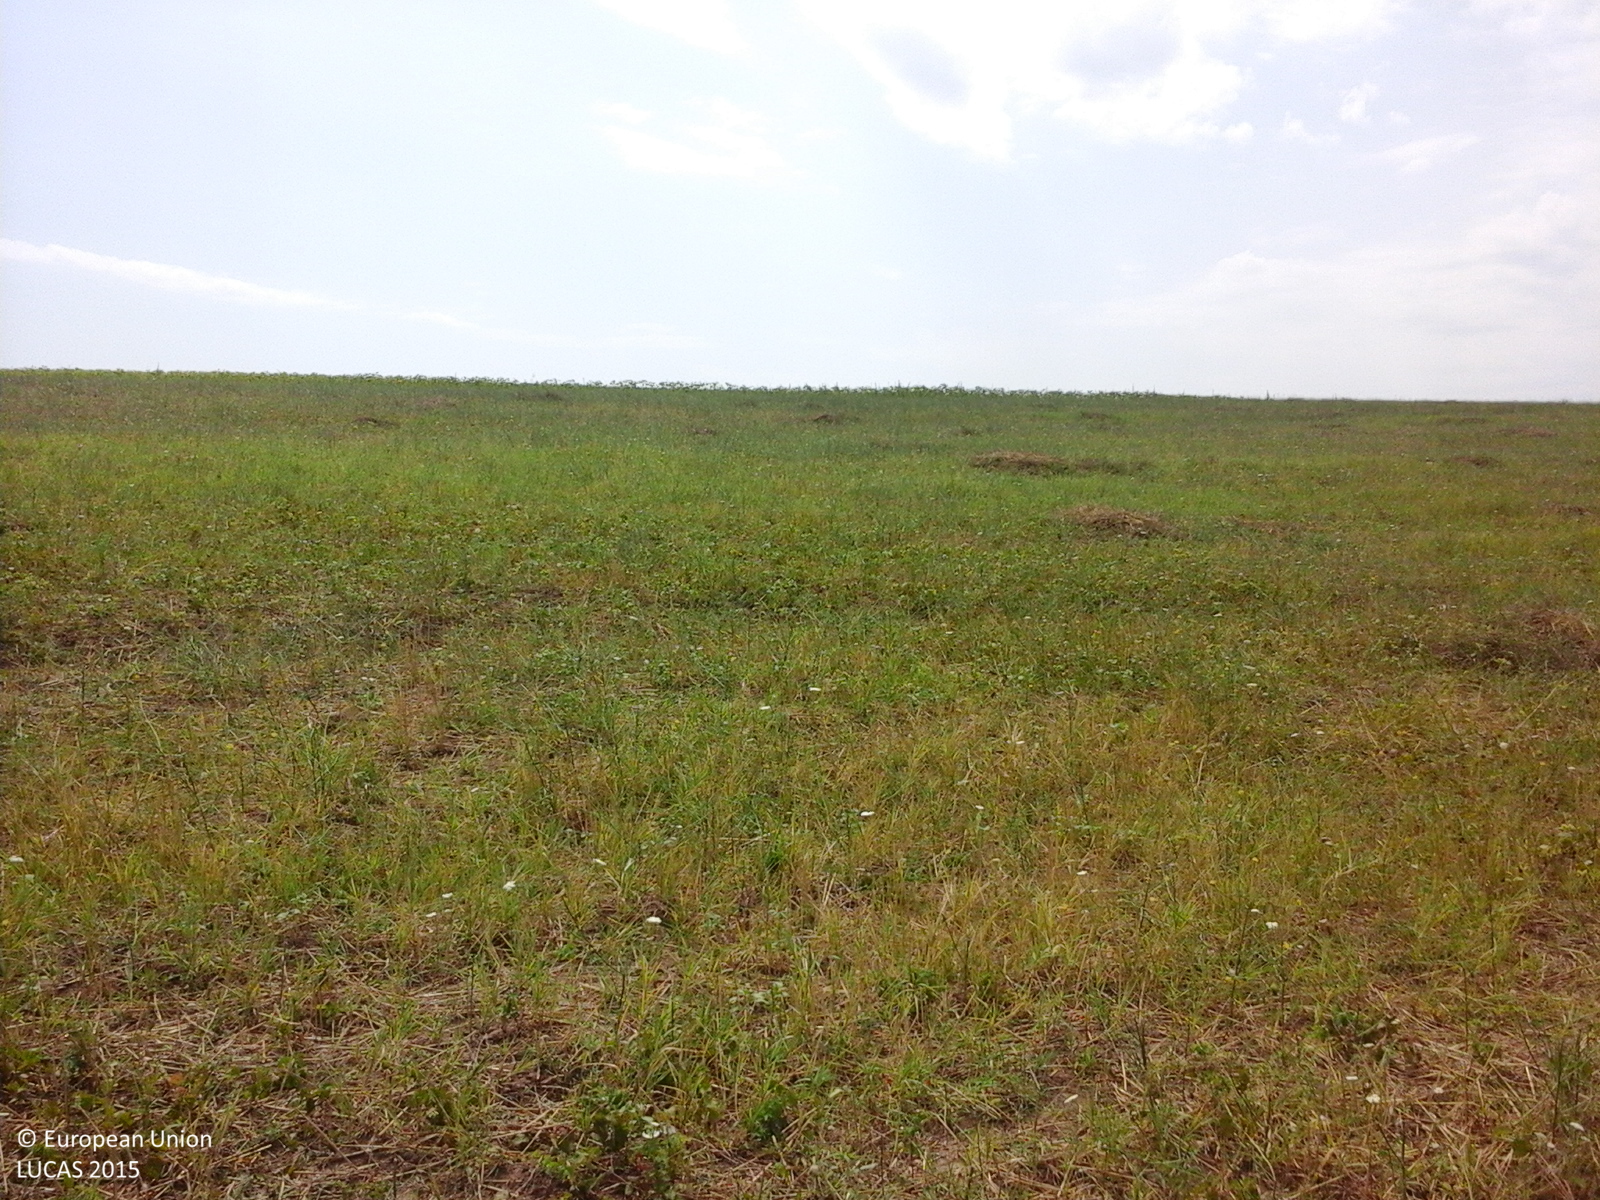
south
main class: Cropland
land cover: Common wheat
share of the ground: 10 - 25 %
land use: Agriculture (excluding fallow land and kitchen gardens)
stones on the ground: < 10 %
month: August
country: RO
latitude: 44.1623
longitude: 27.8953
